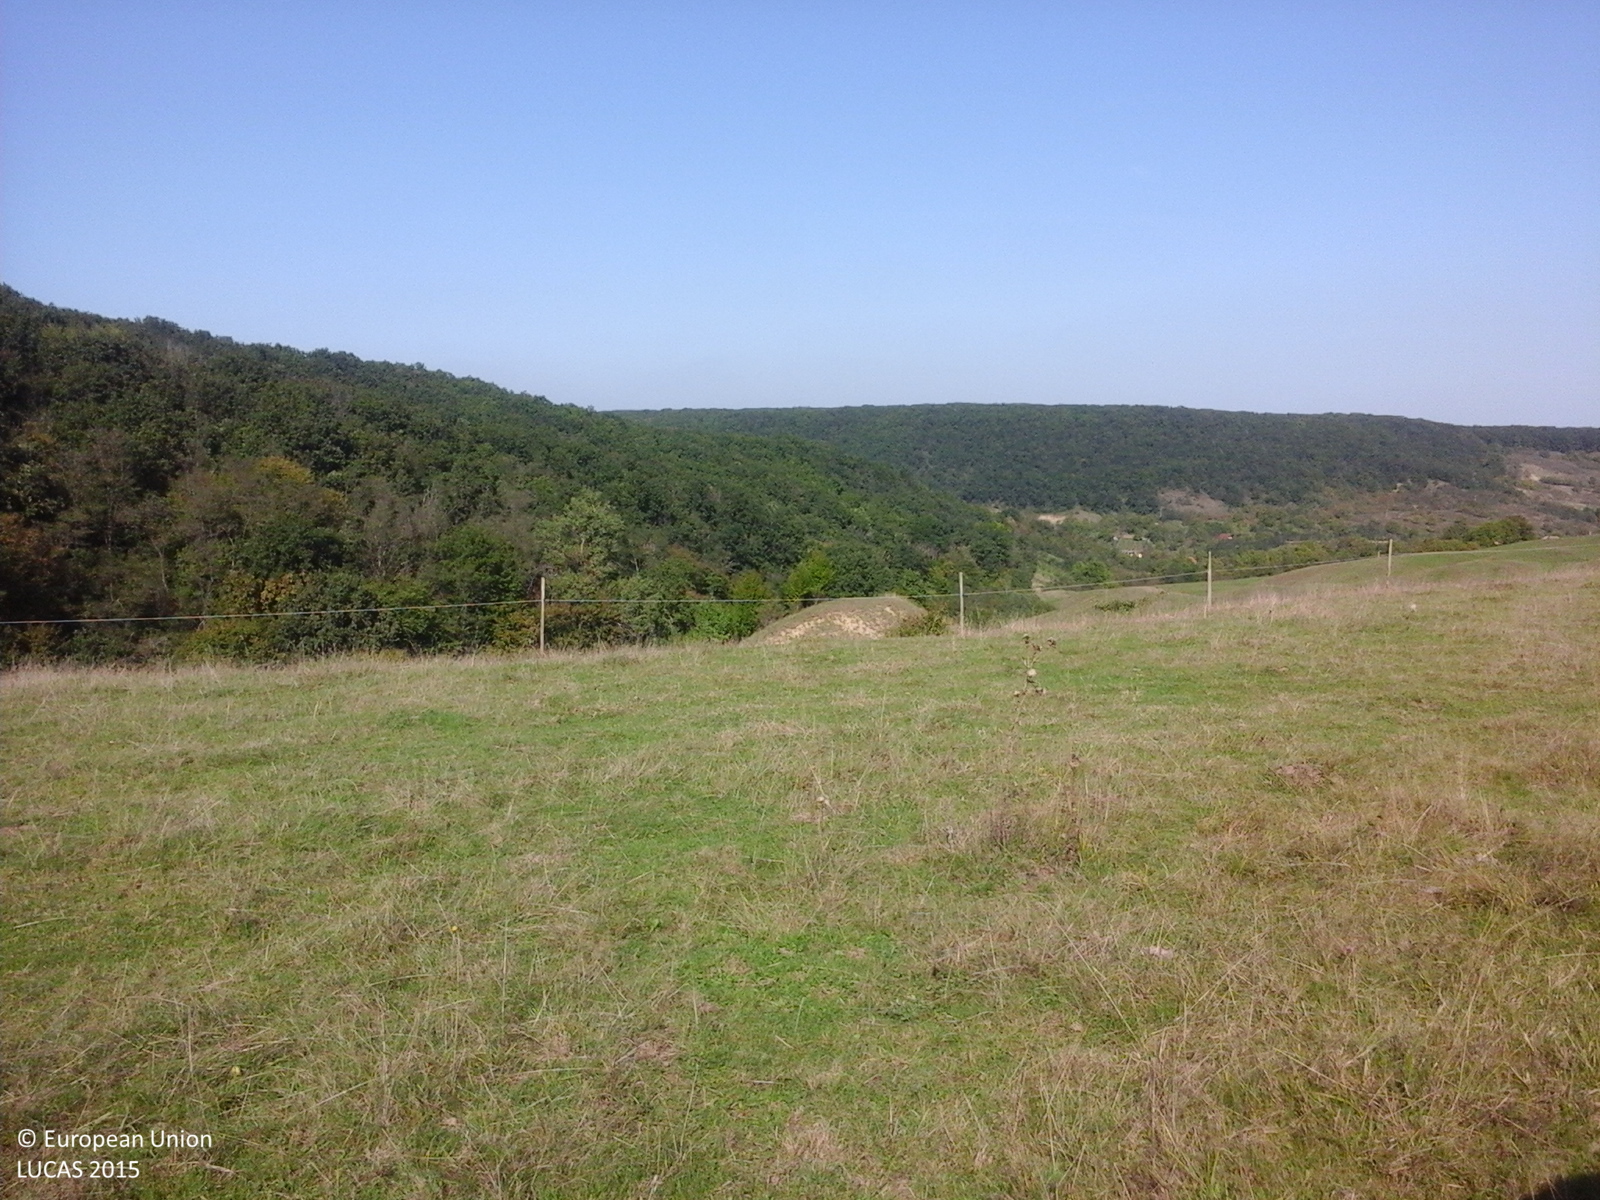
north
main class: Grassland
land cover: Grassland without tree/shrub cover
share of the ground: > 75 %
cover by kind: herbaceous plants 100 %
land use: Agriculture (excluding fallow land and kitchen gardens)
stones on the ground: < 10 %
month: October
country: RO
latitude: 46.2561
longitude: 23.6509
